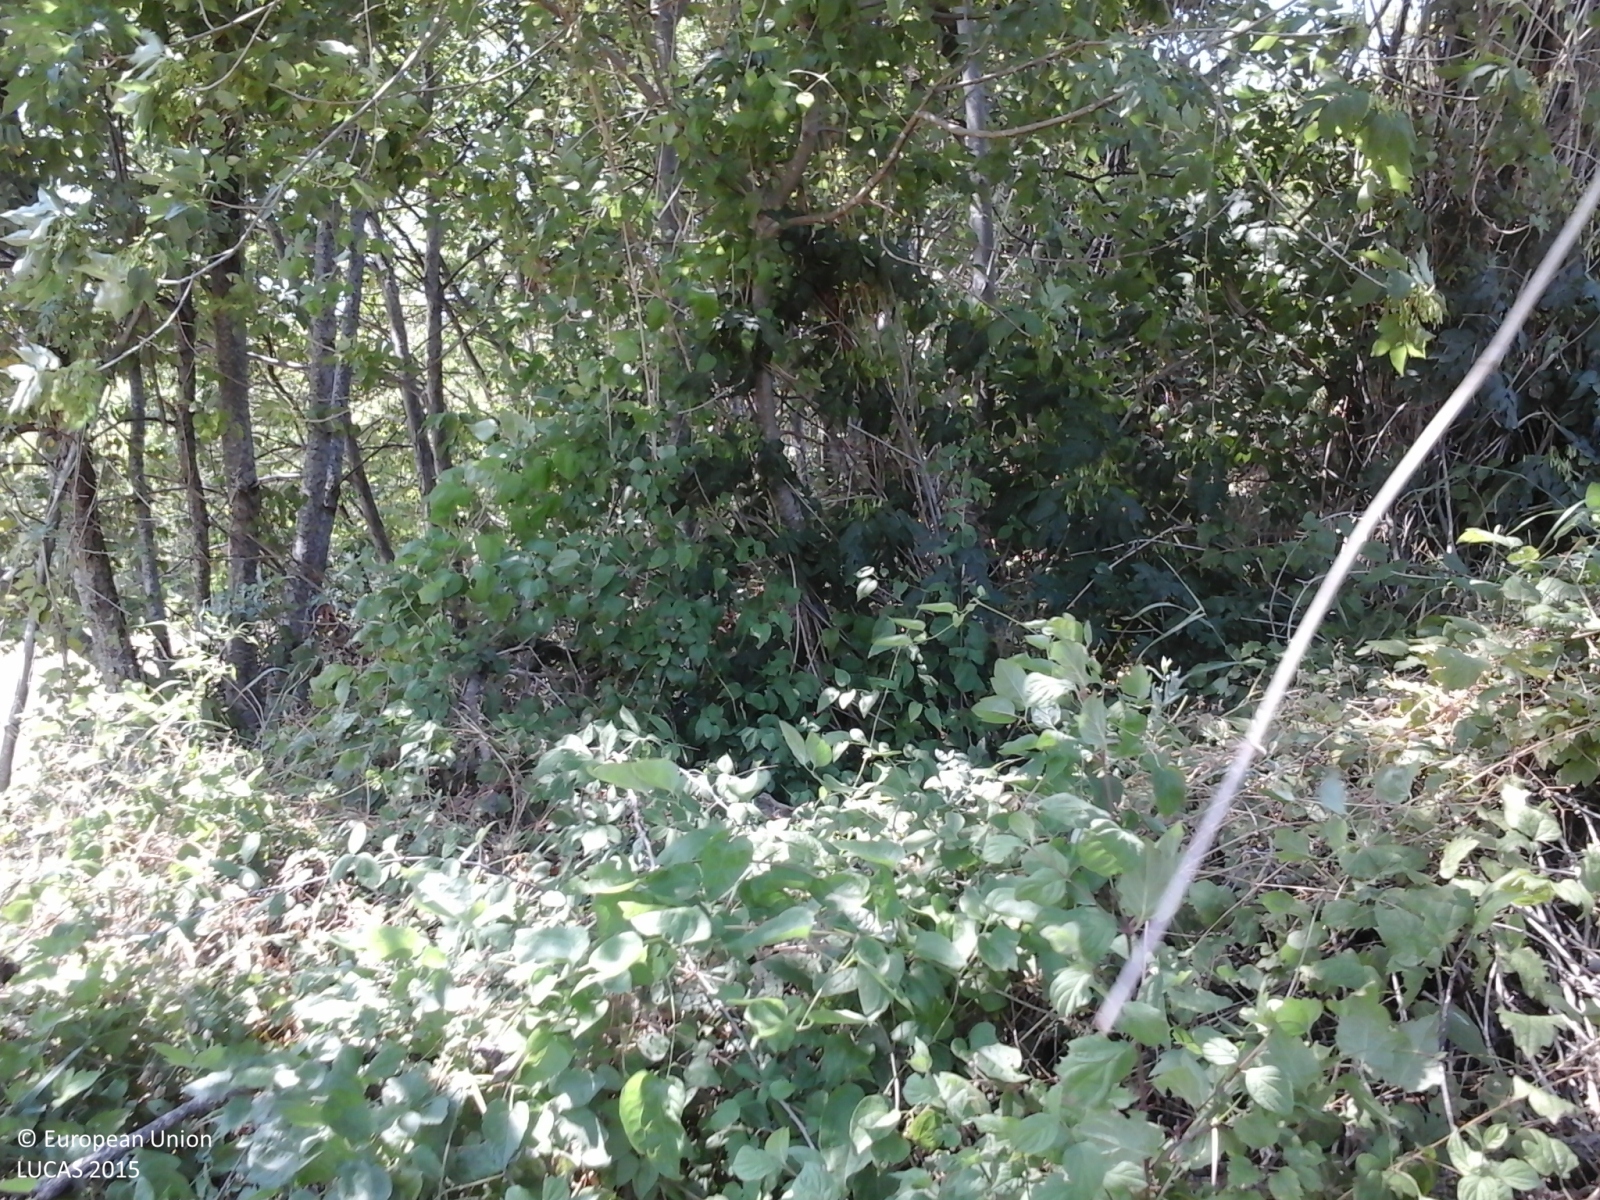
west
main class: Woodland
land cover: Broadleaved woodland
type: thermophilous deciduous forest
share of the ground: > 75 %
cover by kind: broadleaved forest trees 100 %
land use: Forestry
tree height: > 5 m
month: August
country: IT
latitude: 43.6942
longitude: 12.2648
